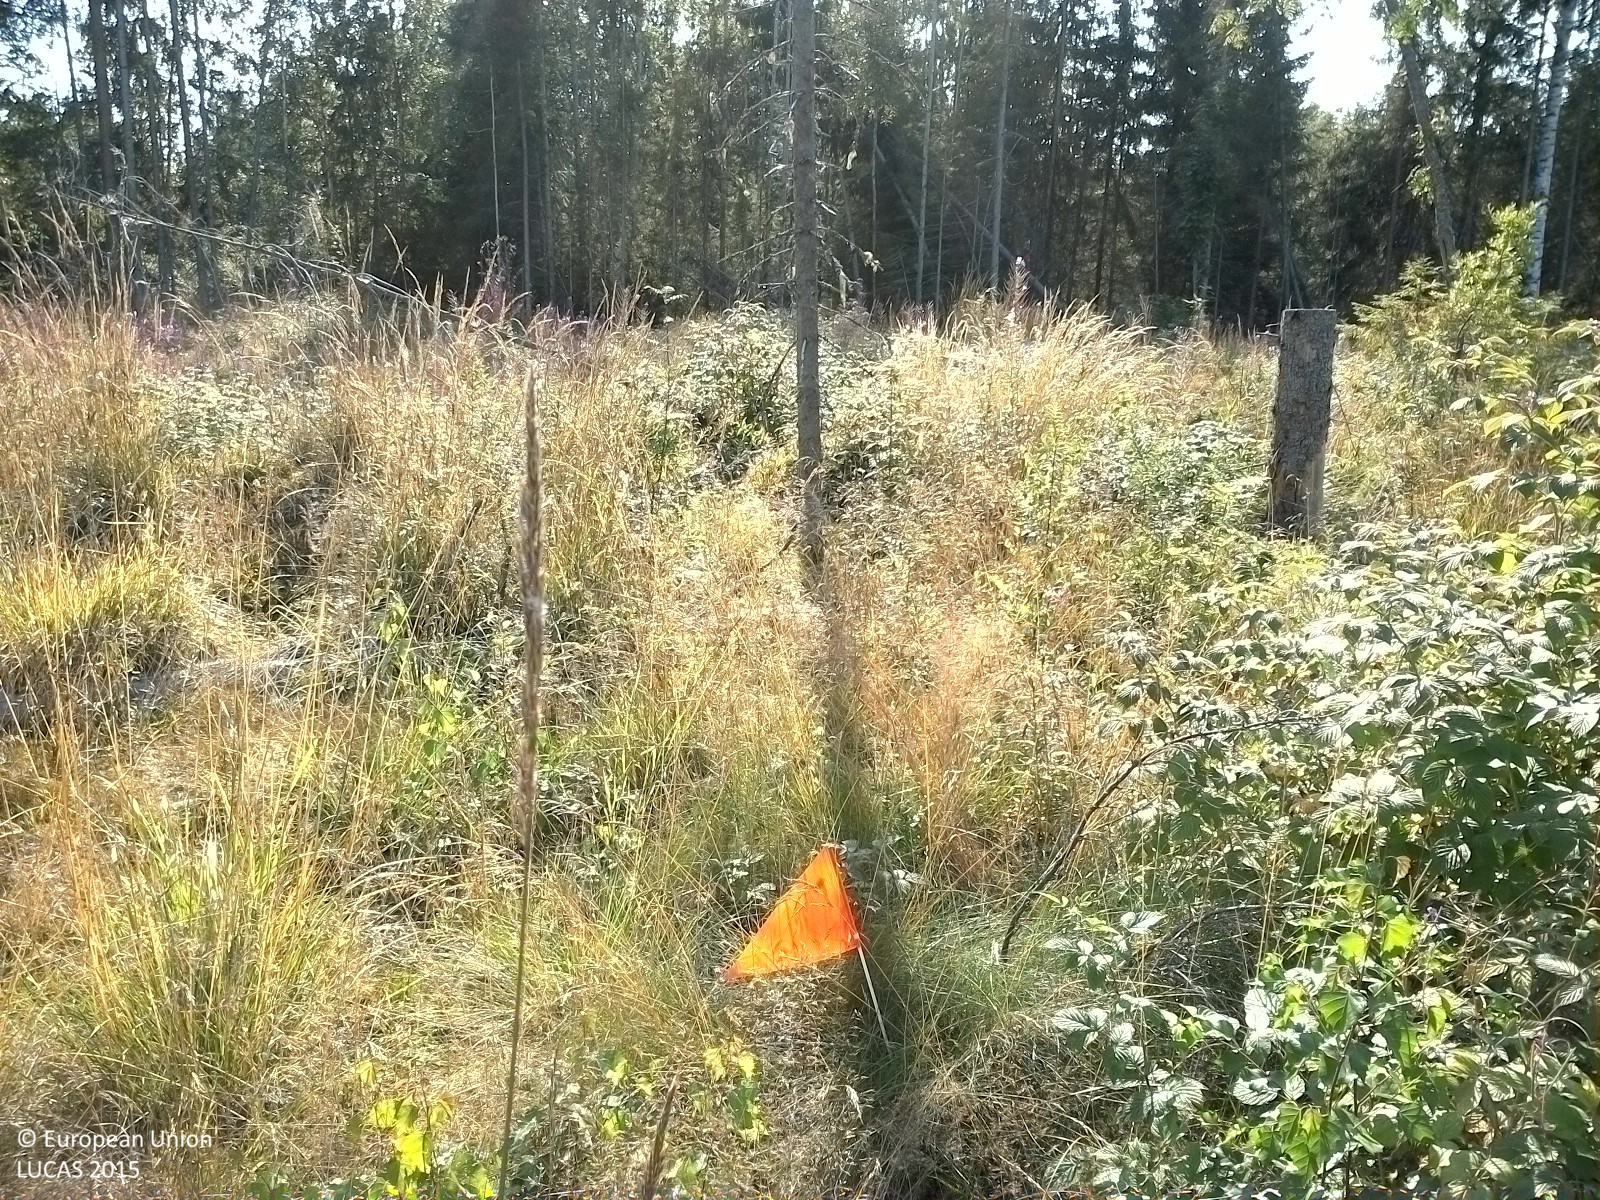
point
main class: Woodland
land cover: Spruce dominated mixed woodland
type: boreal forest
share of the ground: 10 - 25 %
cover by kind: herbaceous plants 50 %, shrubs 30 %, coniferous forest trees 10 %, broadleaved forest trees 10 %
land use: Forestry
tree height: < 5 m
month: August
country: SE
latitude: 62.4616
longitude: 16.3191
